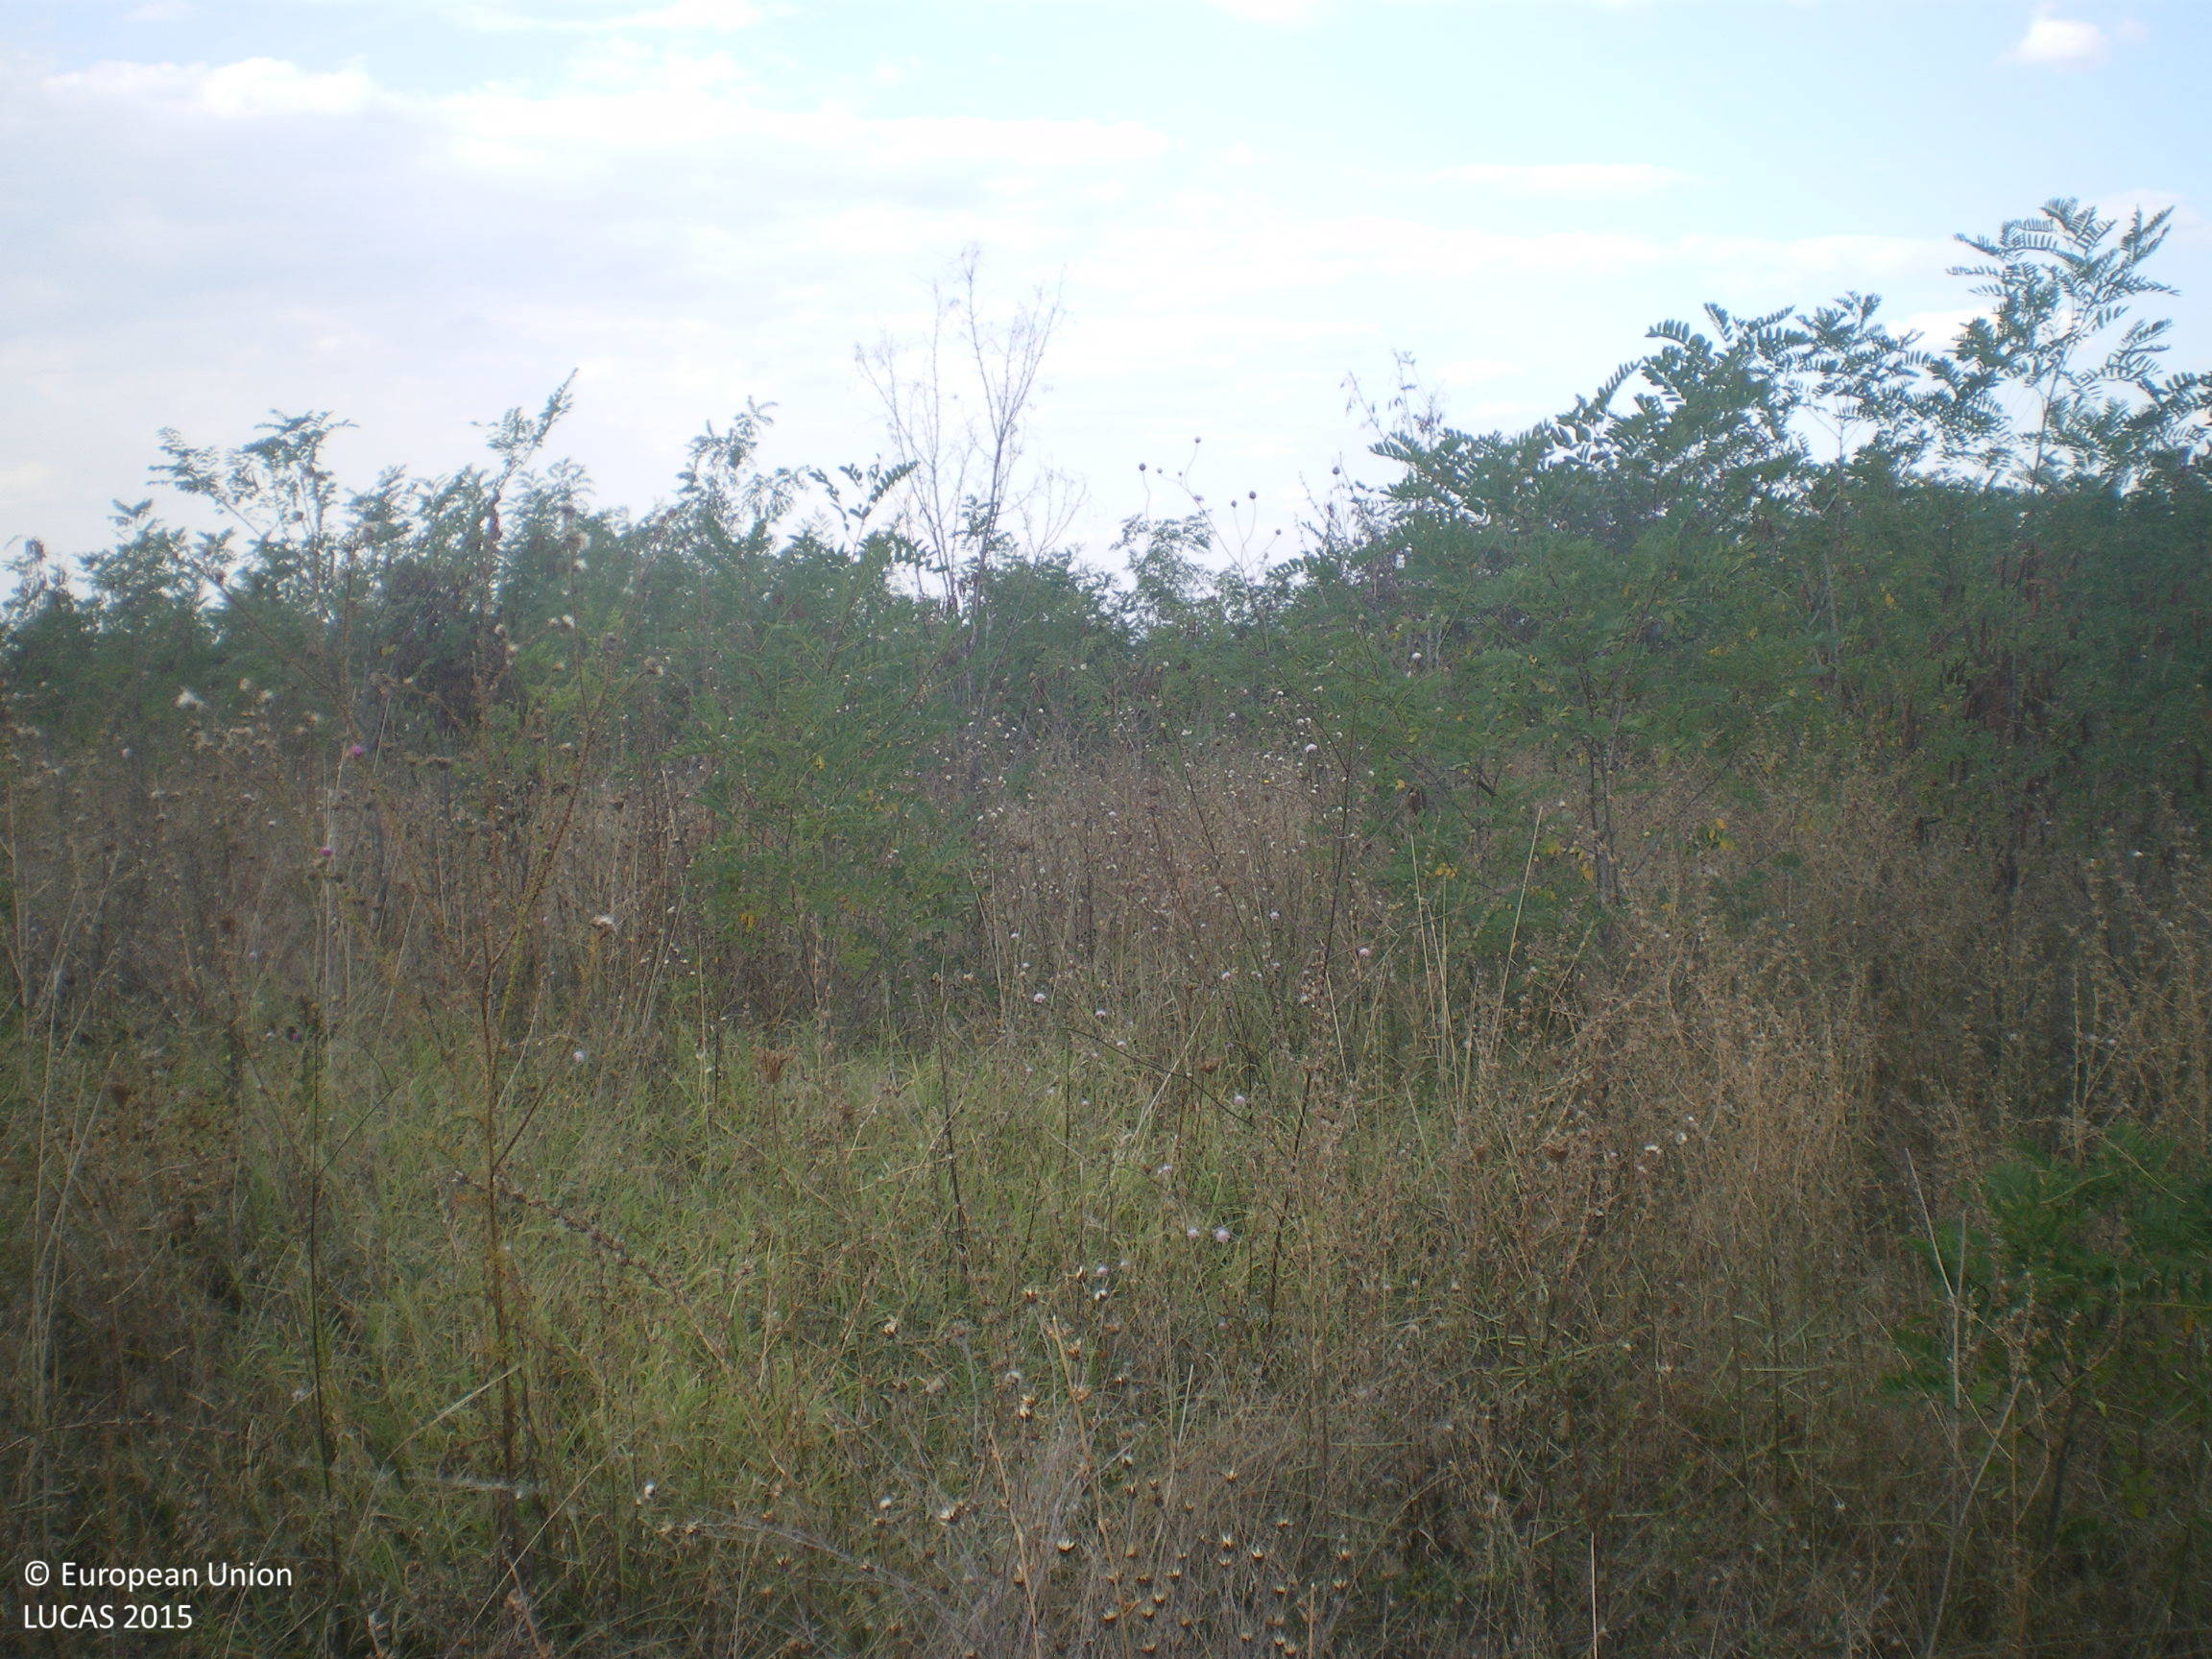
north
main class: Grassland
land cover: Grassland with sparse tree/shrub cover
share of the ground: > 75 %
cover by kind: herbaceous plants 85 %, shrubs 10 %, broadleaved forest trees 5 %
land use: Agriculture (excluding fallow land and kitchen gardens)
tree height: < 5 m
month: September
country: BG
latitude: 42.0956
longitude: 26.0736
